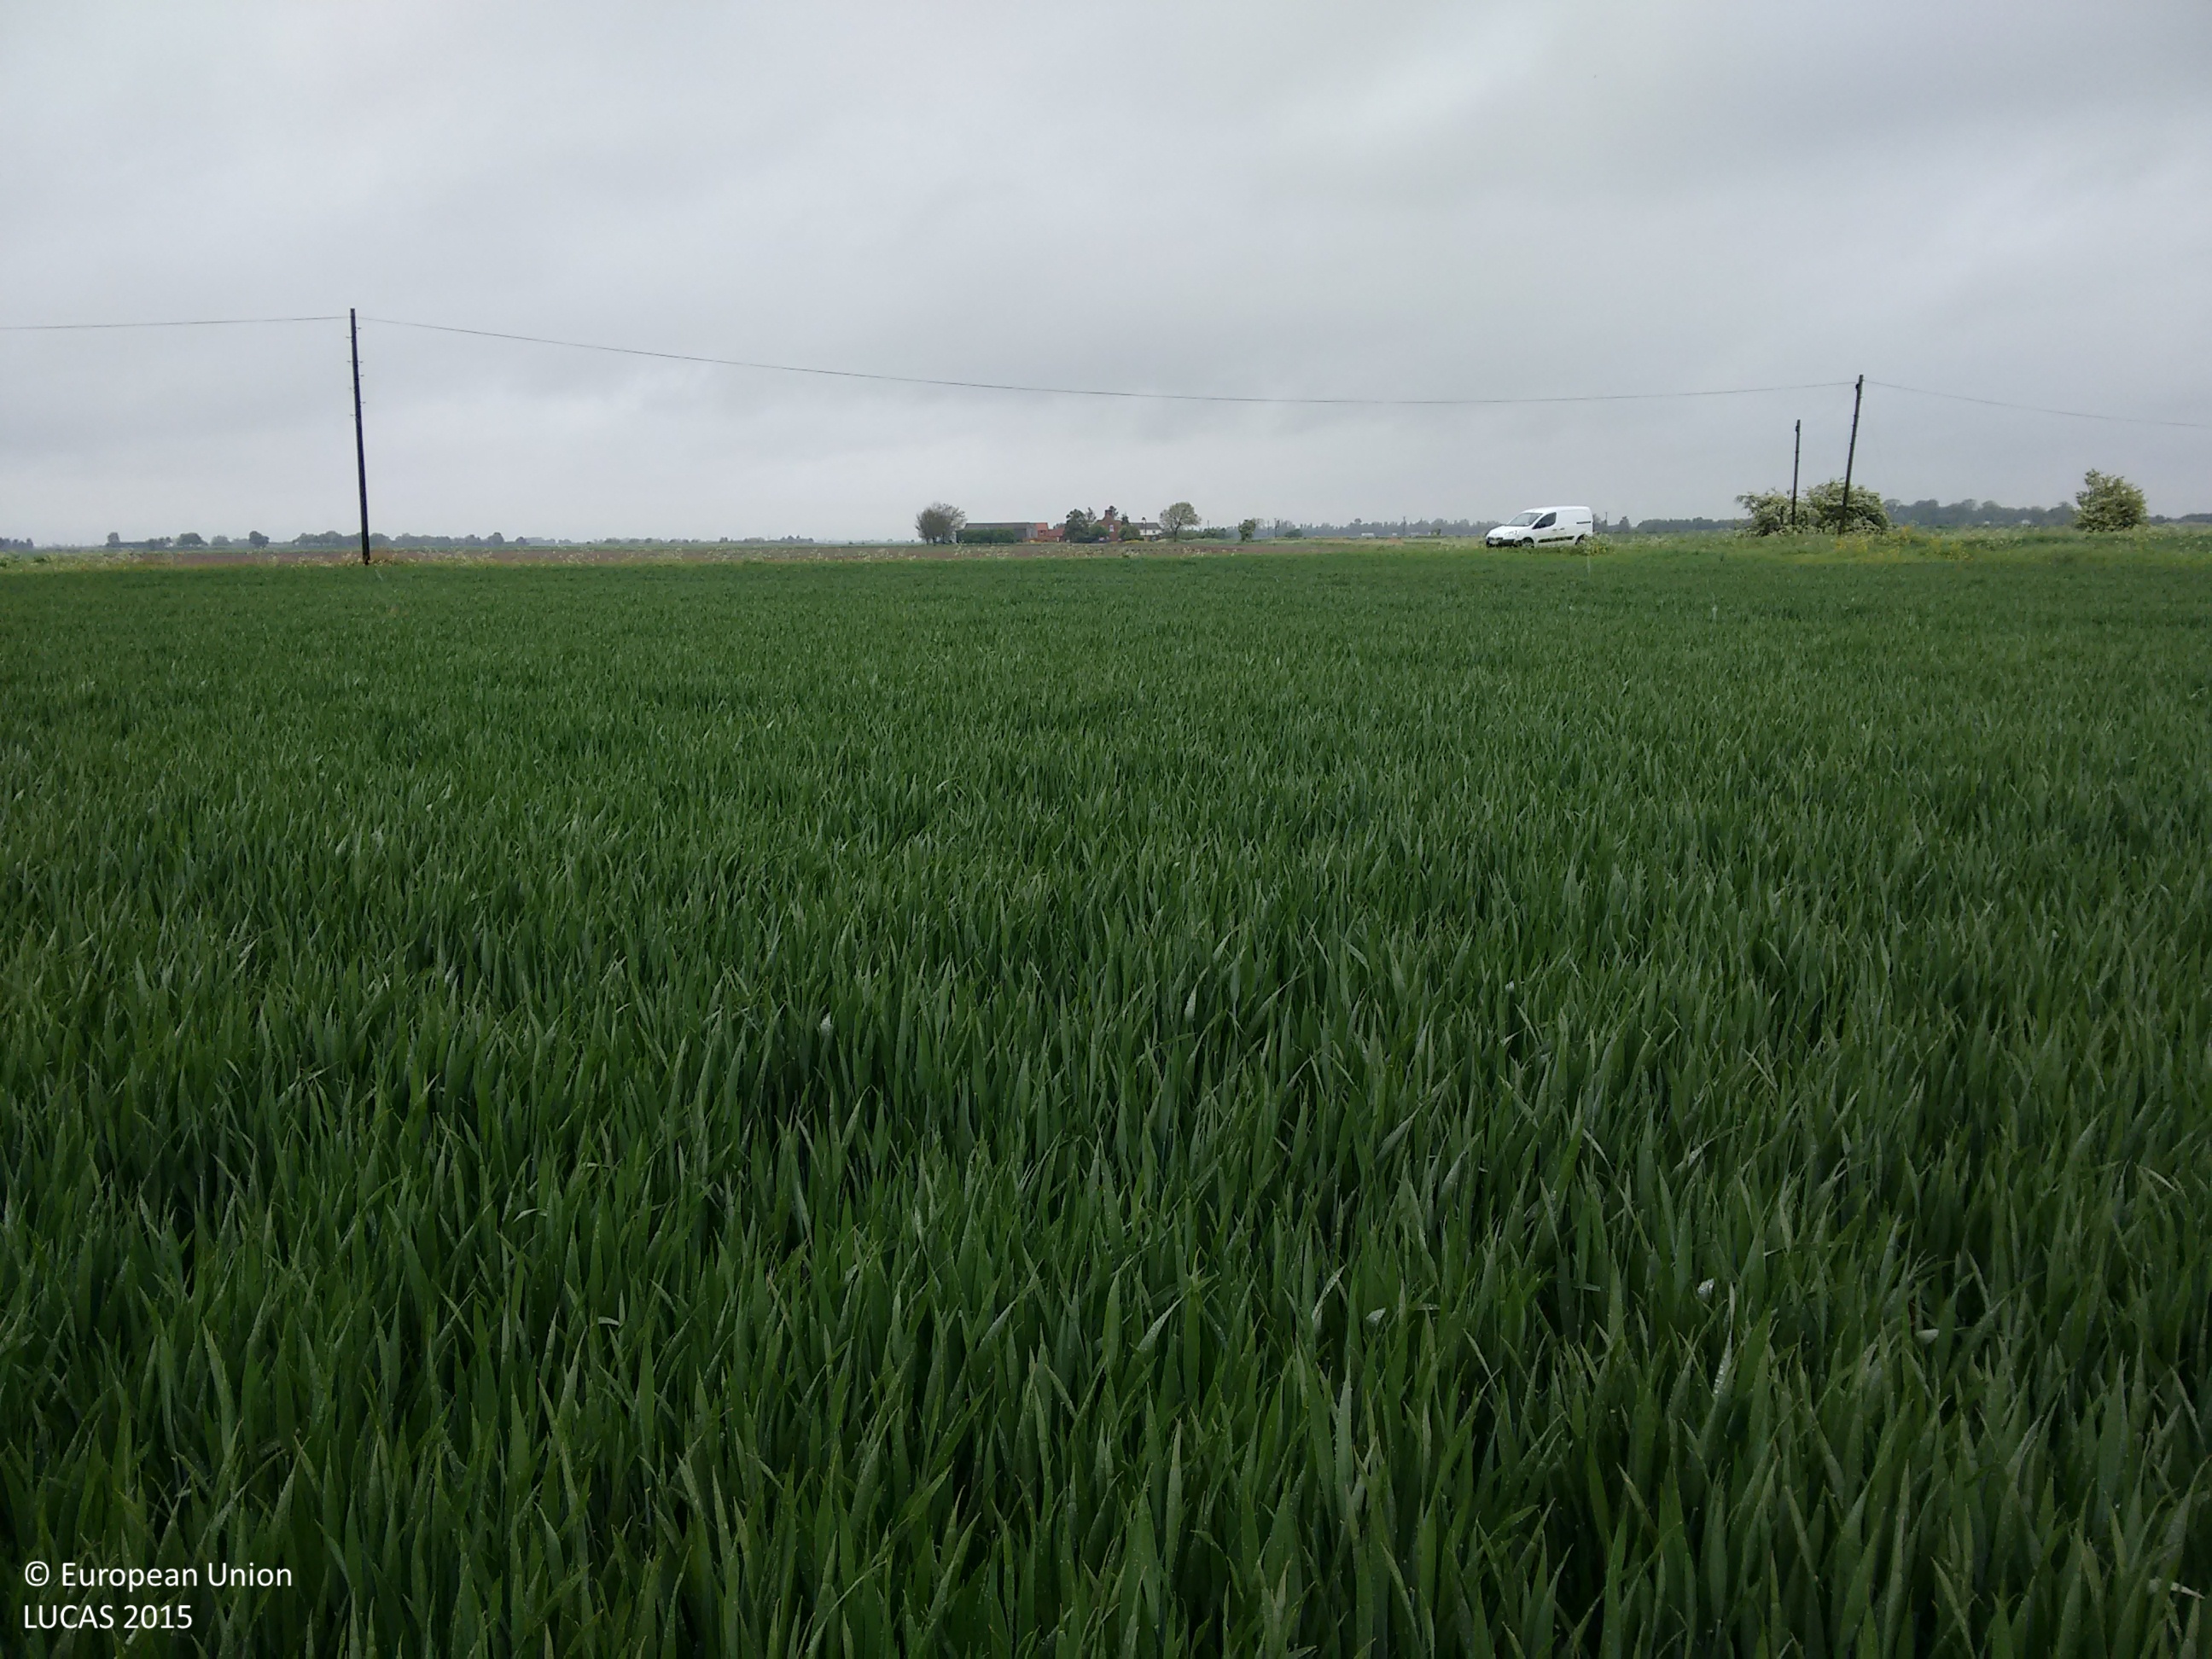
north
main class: Cropland
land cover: Common wheat
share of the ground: > 75 %
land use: Agriculture (excluding fallow land and kitchen gardens)
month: May
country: GB
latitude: 52.8859
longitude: -0.1245
